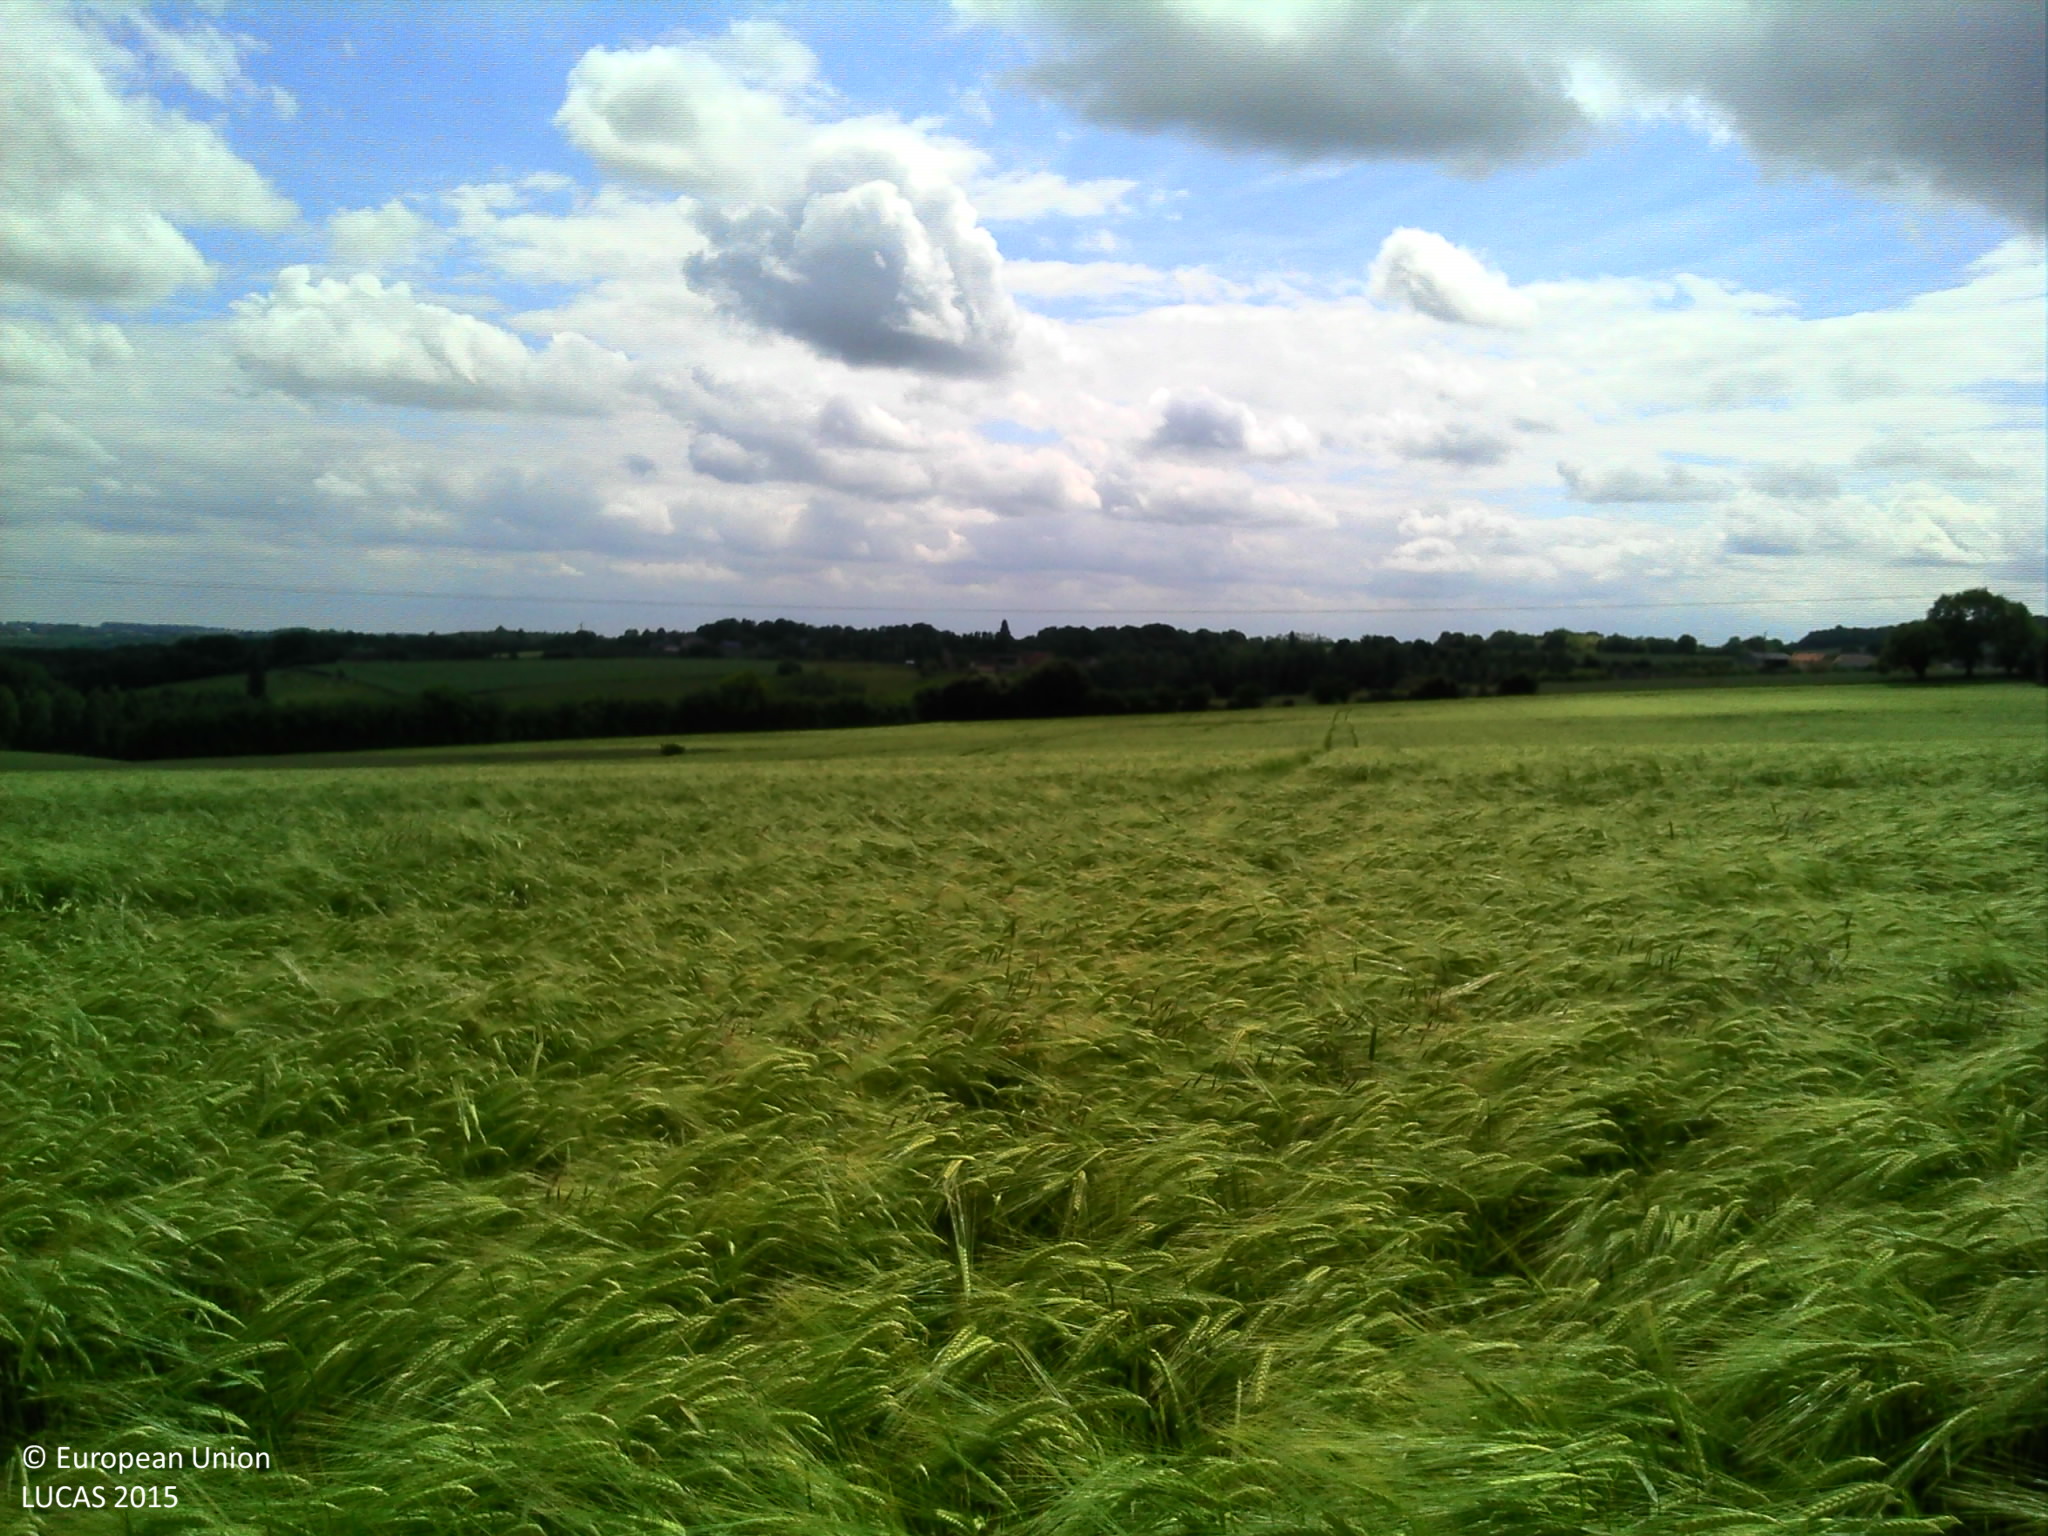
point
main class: Cropland
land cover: Barley
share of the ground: > 75 %
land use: Agriculture (excluding fallow land and kitchen gardens)
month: May
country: FR
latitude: 48.0759
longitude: -0.0009
